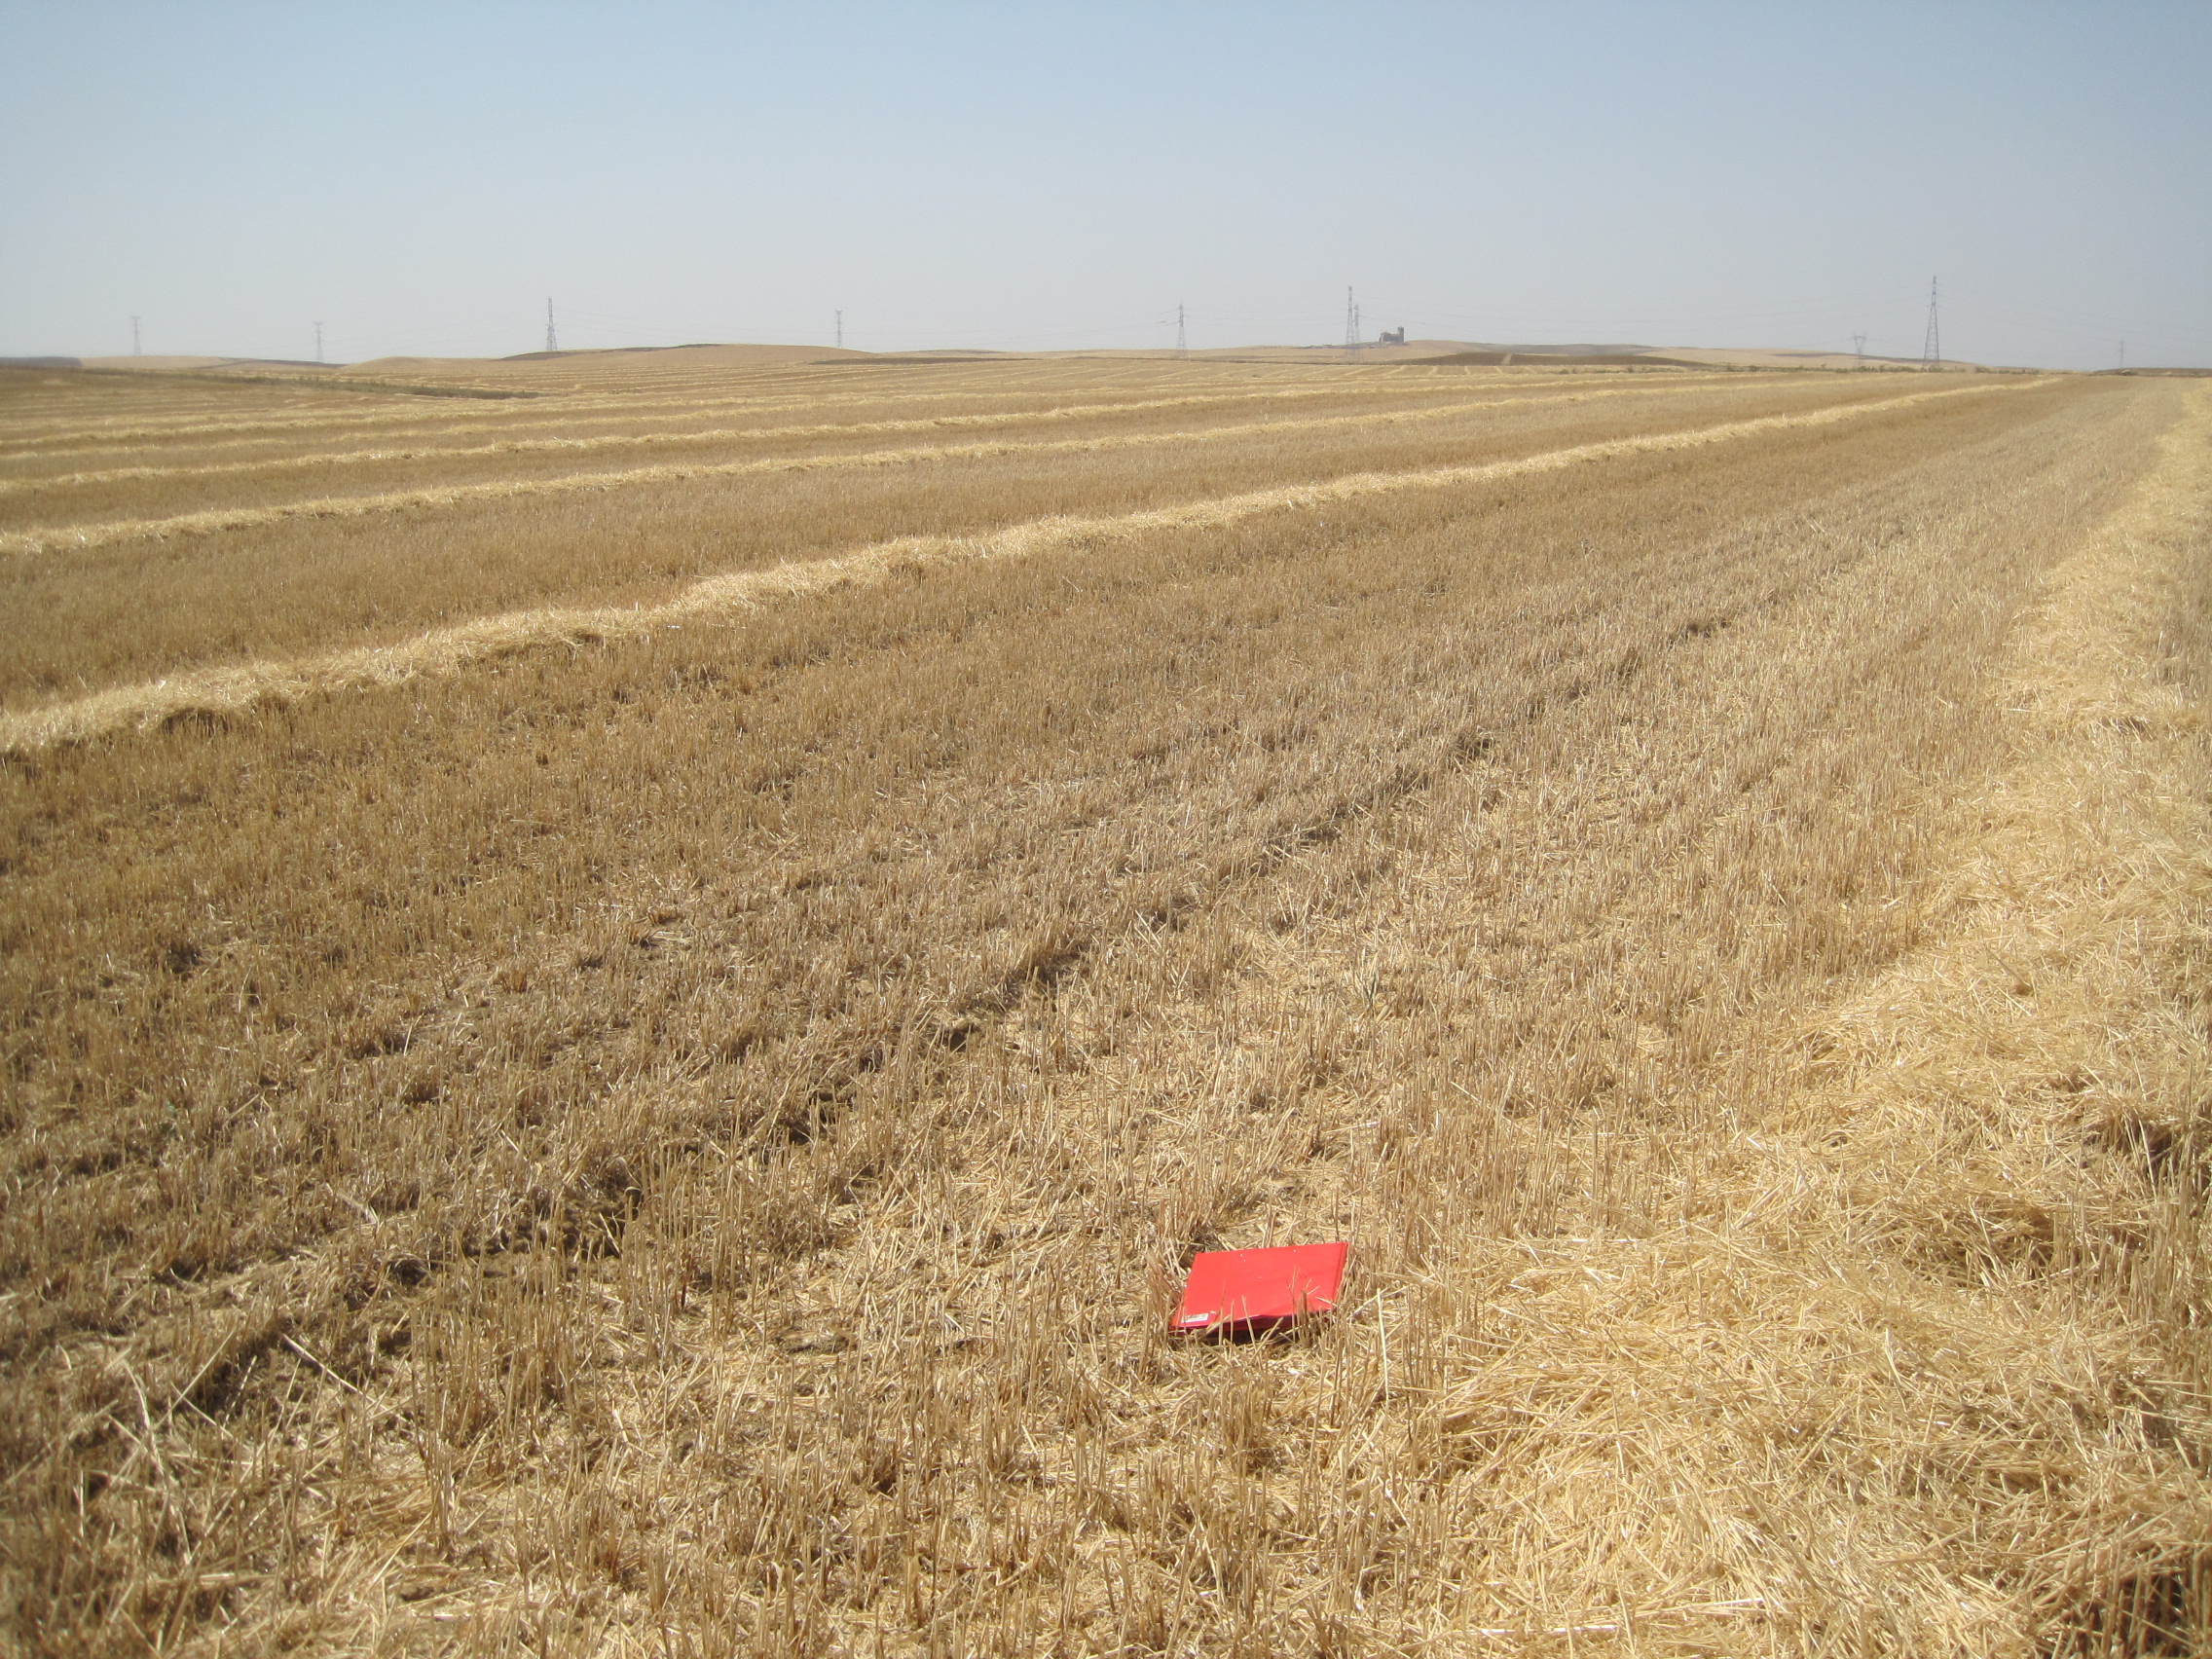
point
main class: Cropland
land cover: Barley
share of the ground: < 10 %
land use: Agriculture (excluding fallow land and kitchen gardens)
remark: Harvested field
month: July
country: ES
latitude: 41.6596
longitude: -5.4665
